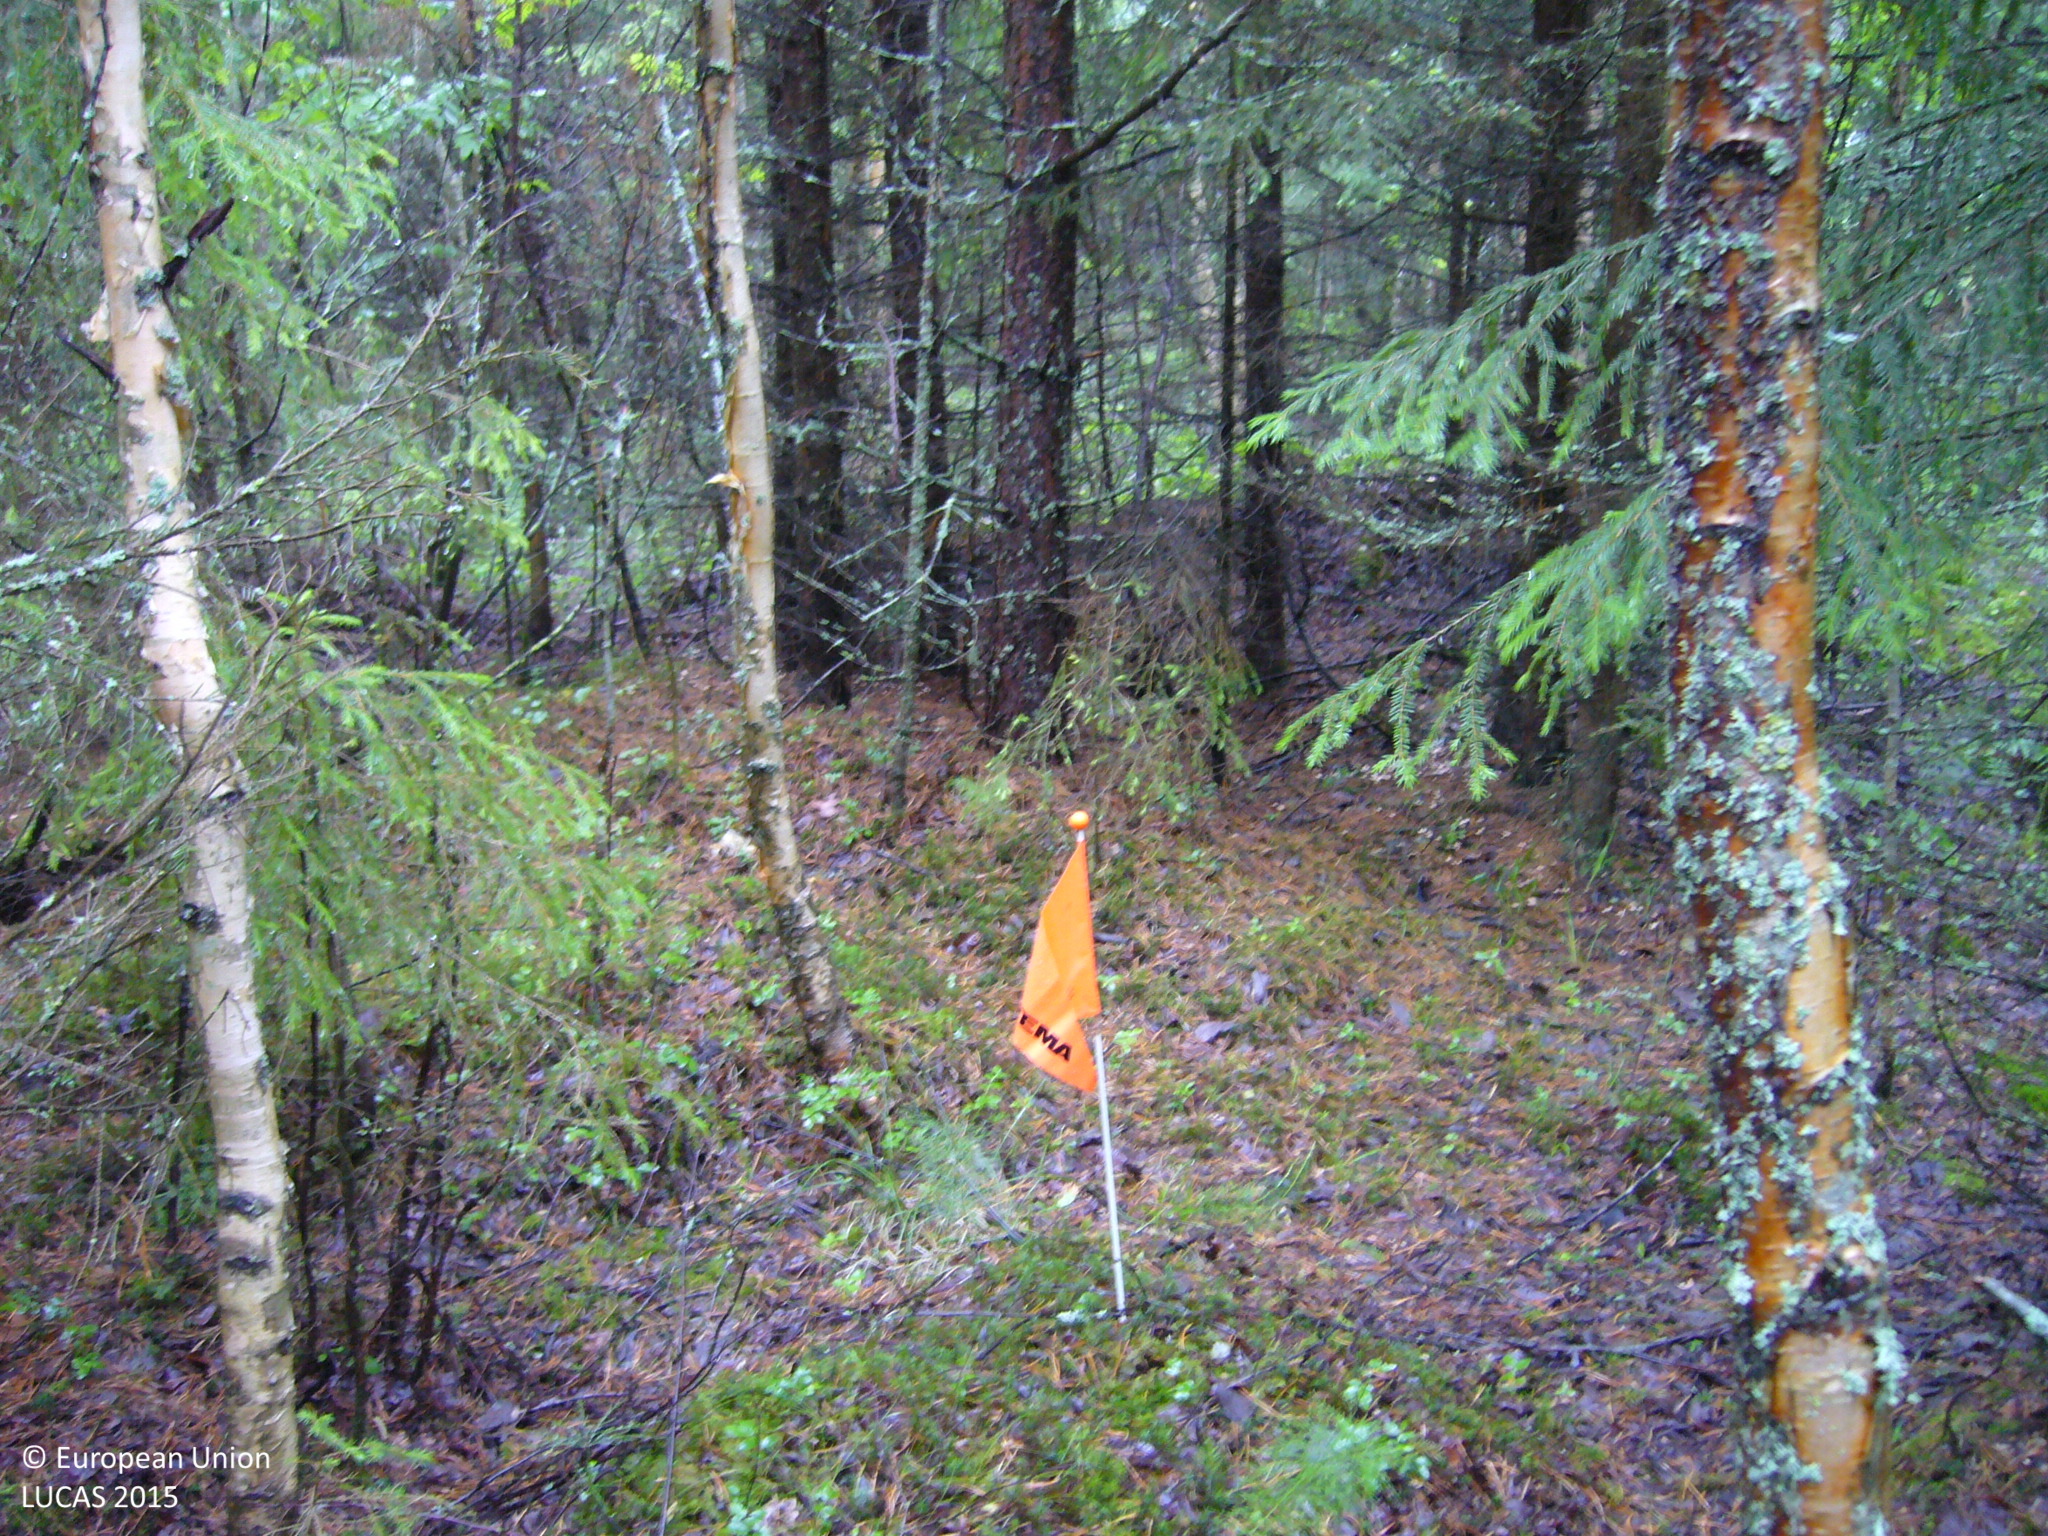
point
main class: Woodland
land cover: Spruce dominated mixed woodland
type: boreal forest
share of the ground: > 75 %
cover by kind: coniferous forest trees 65 %, broadleaved forest trees 30 %, shrubs 5 %
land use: Forestry
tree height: > 5 m
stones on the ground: < 10 %
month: June
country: FI
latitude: 63.6969
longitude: 26.2800
